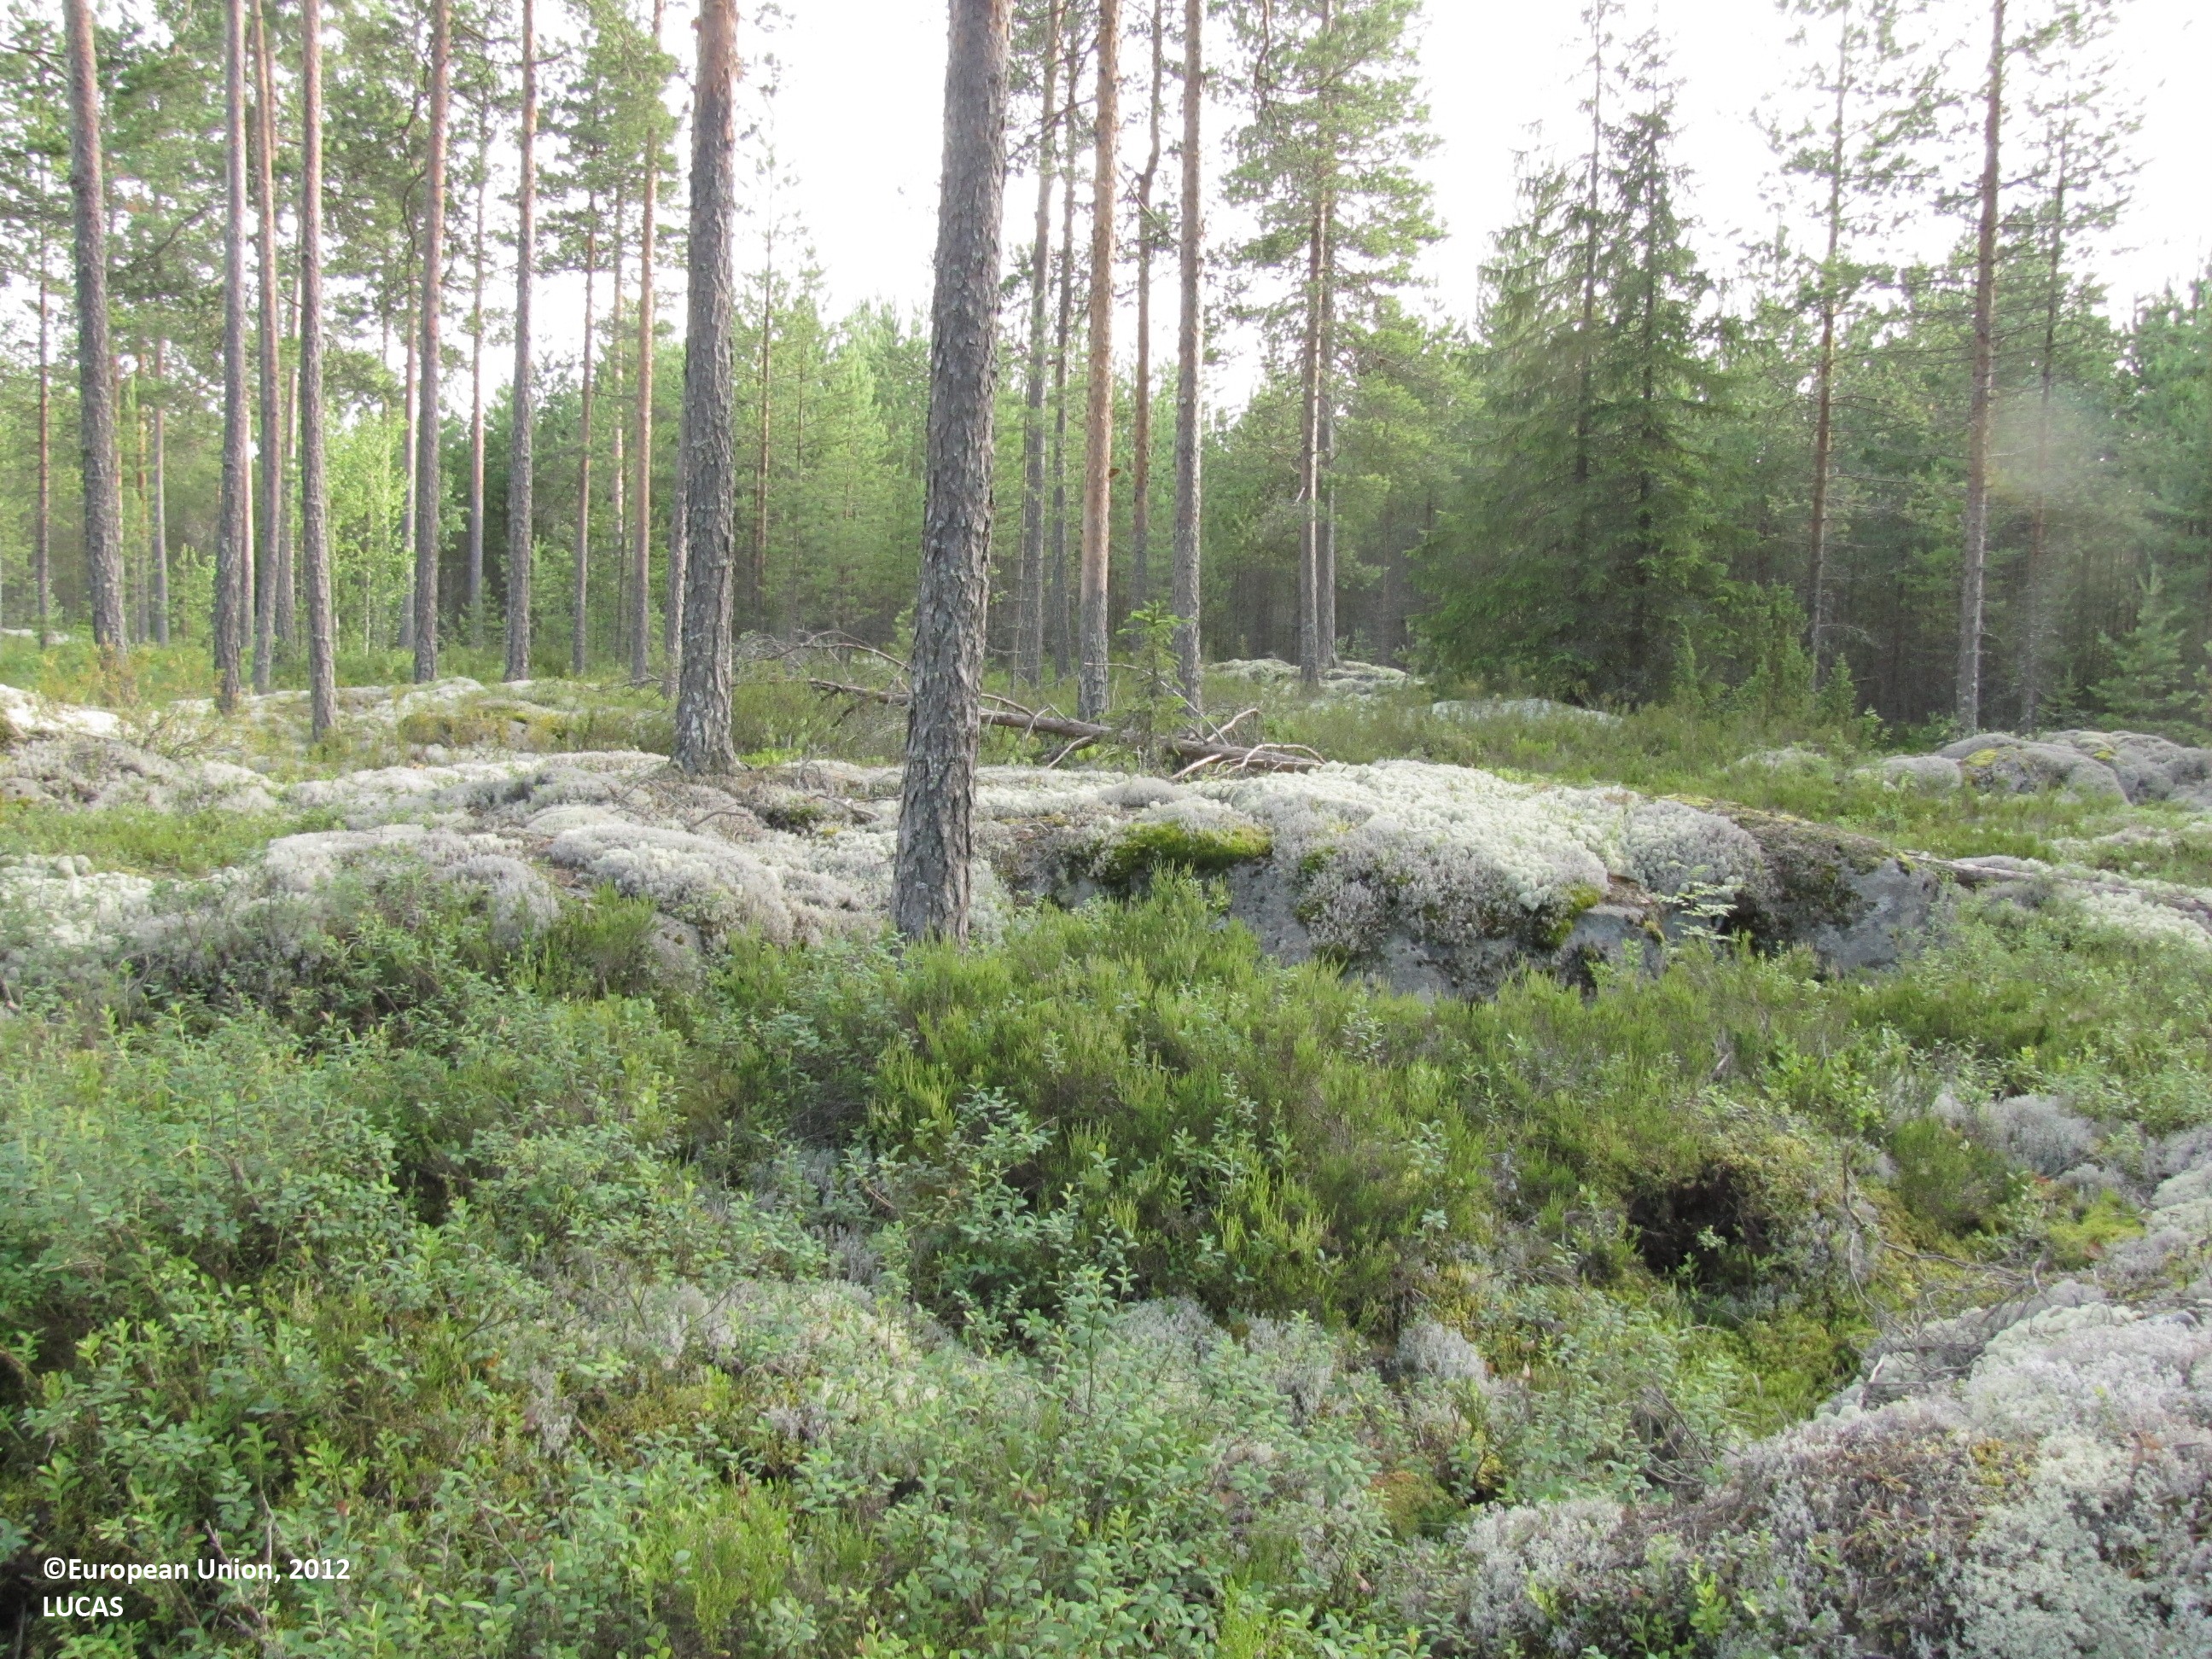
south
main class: Woodland
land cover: Pine dominated coniferous woodland
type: boreal forest
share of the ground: > 75 %
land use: Forestry
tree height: > 5 m
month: July
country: FI
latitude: 62.5259
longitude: 23.5756
